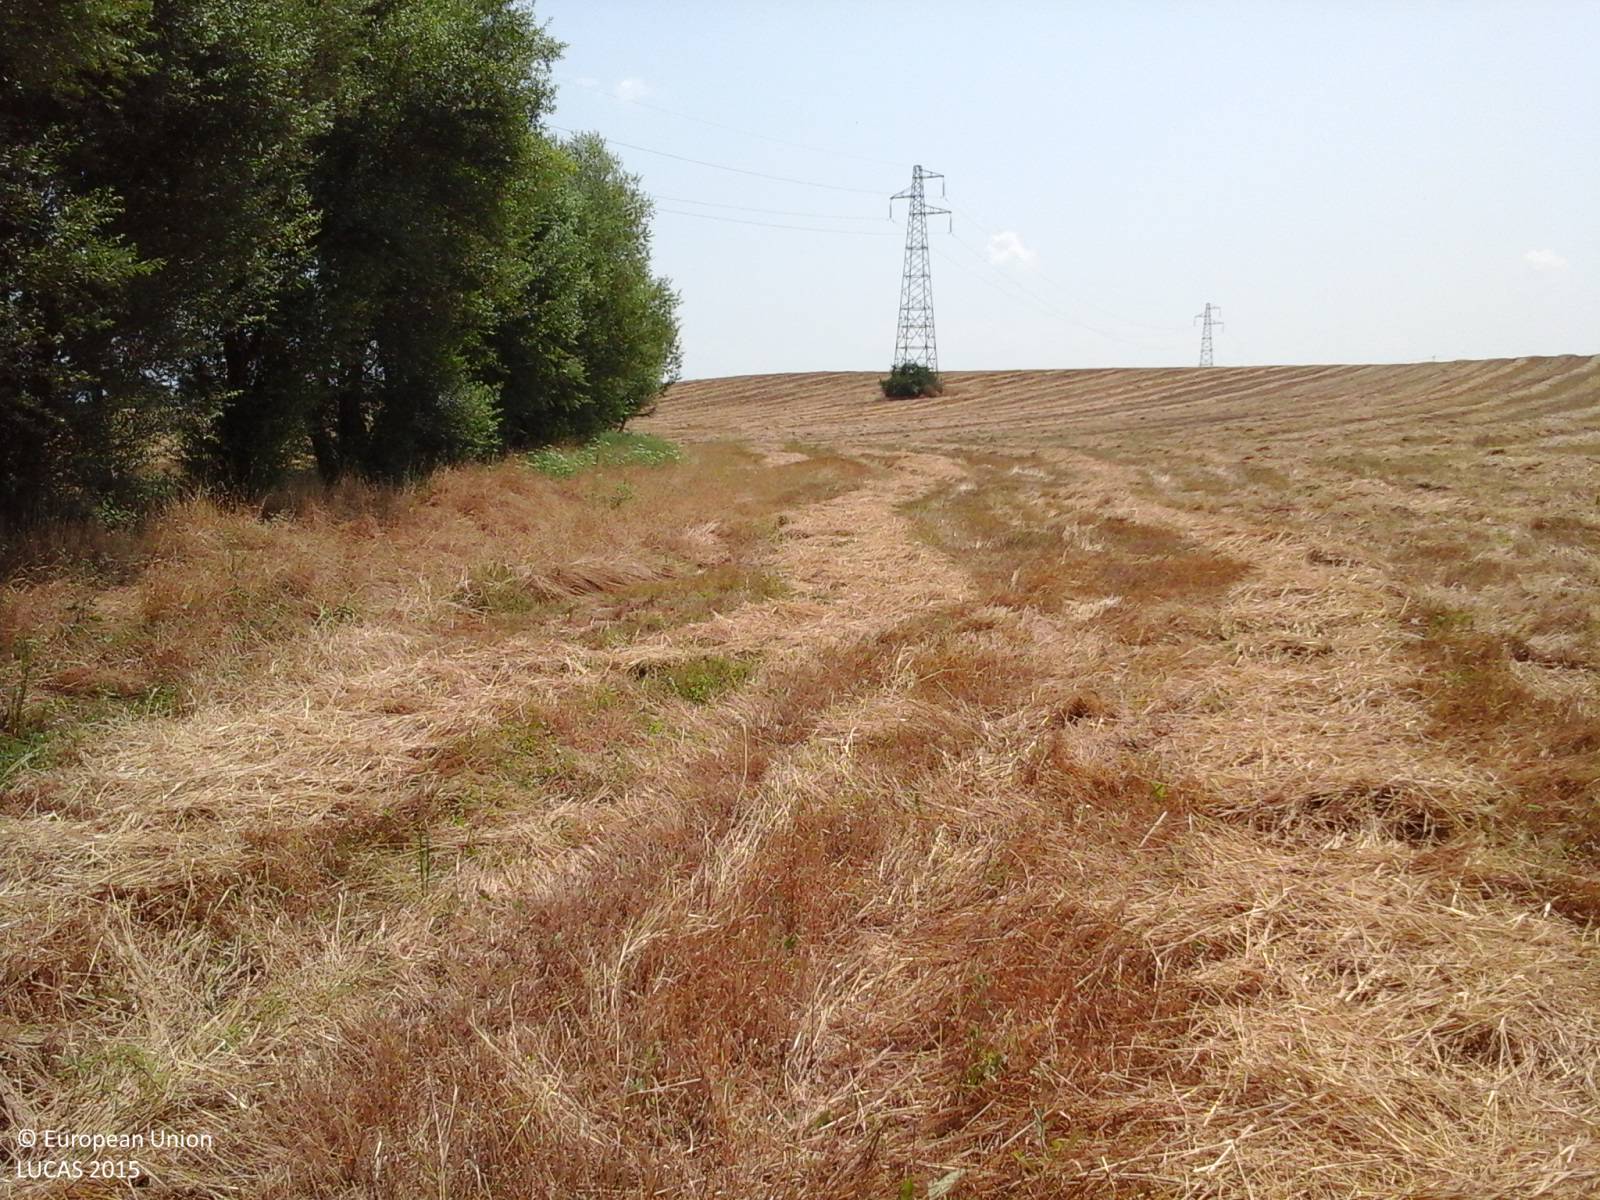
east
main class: Cropland
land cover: Temporary grasslands
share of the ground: > 75 %
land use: Agriculture (excluding fallow land and kitchen gardens)
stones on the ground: < 10 %
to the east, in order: Temporary grasslands; Lines of trees; Temporary grasslands; Electric lines; Temporary grasslands
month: July
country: IT
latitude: 41.9710
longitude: 12.5609
